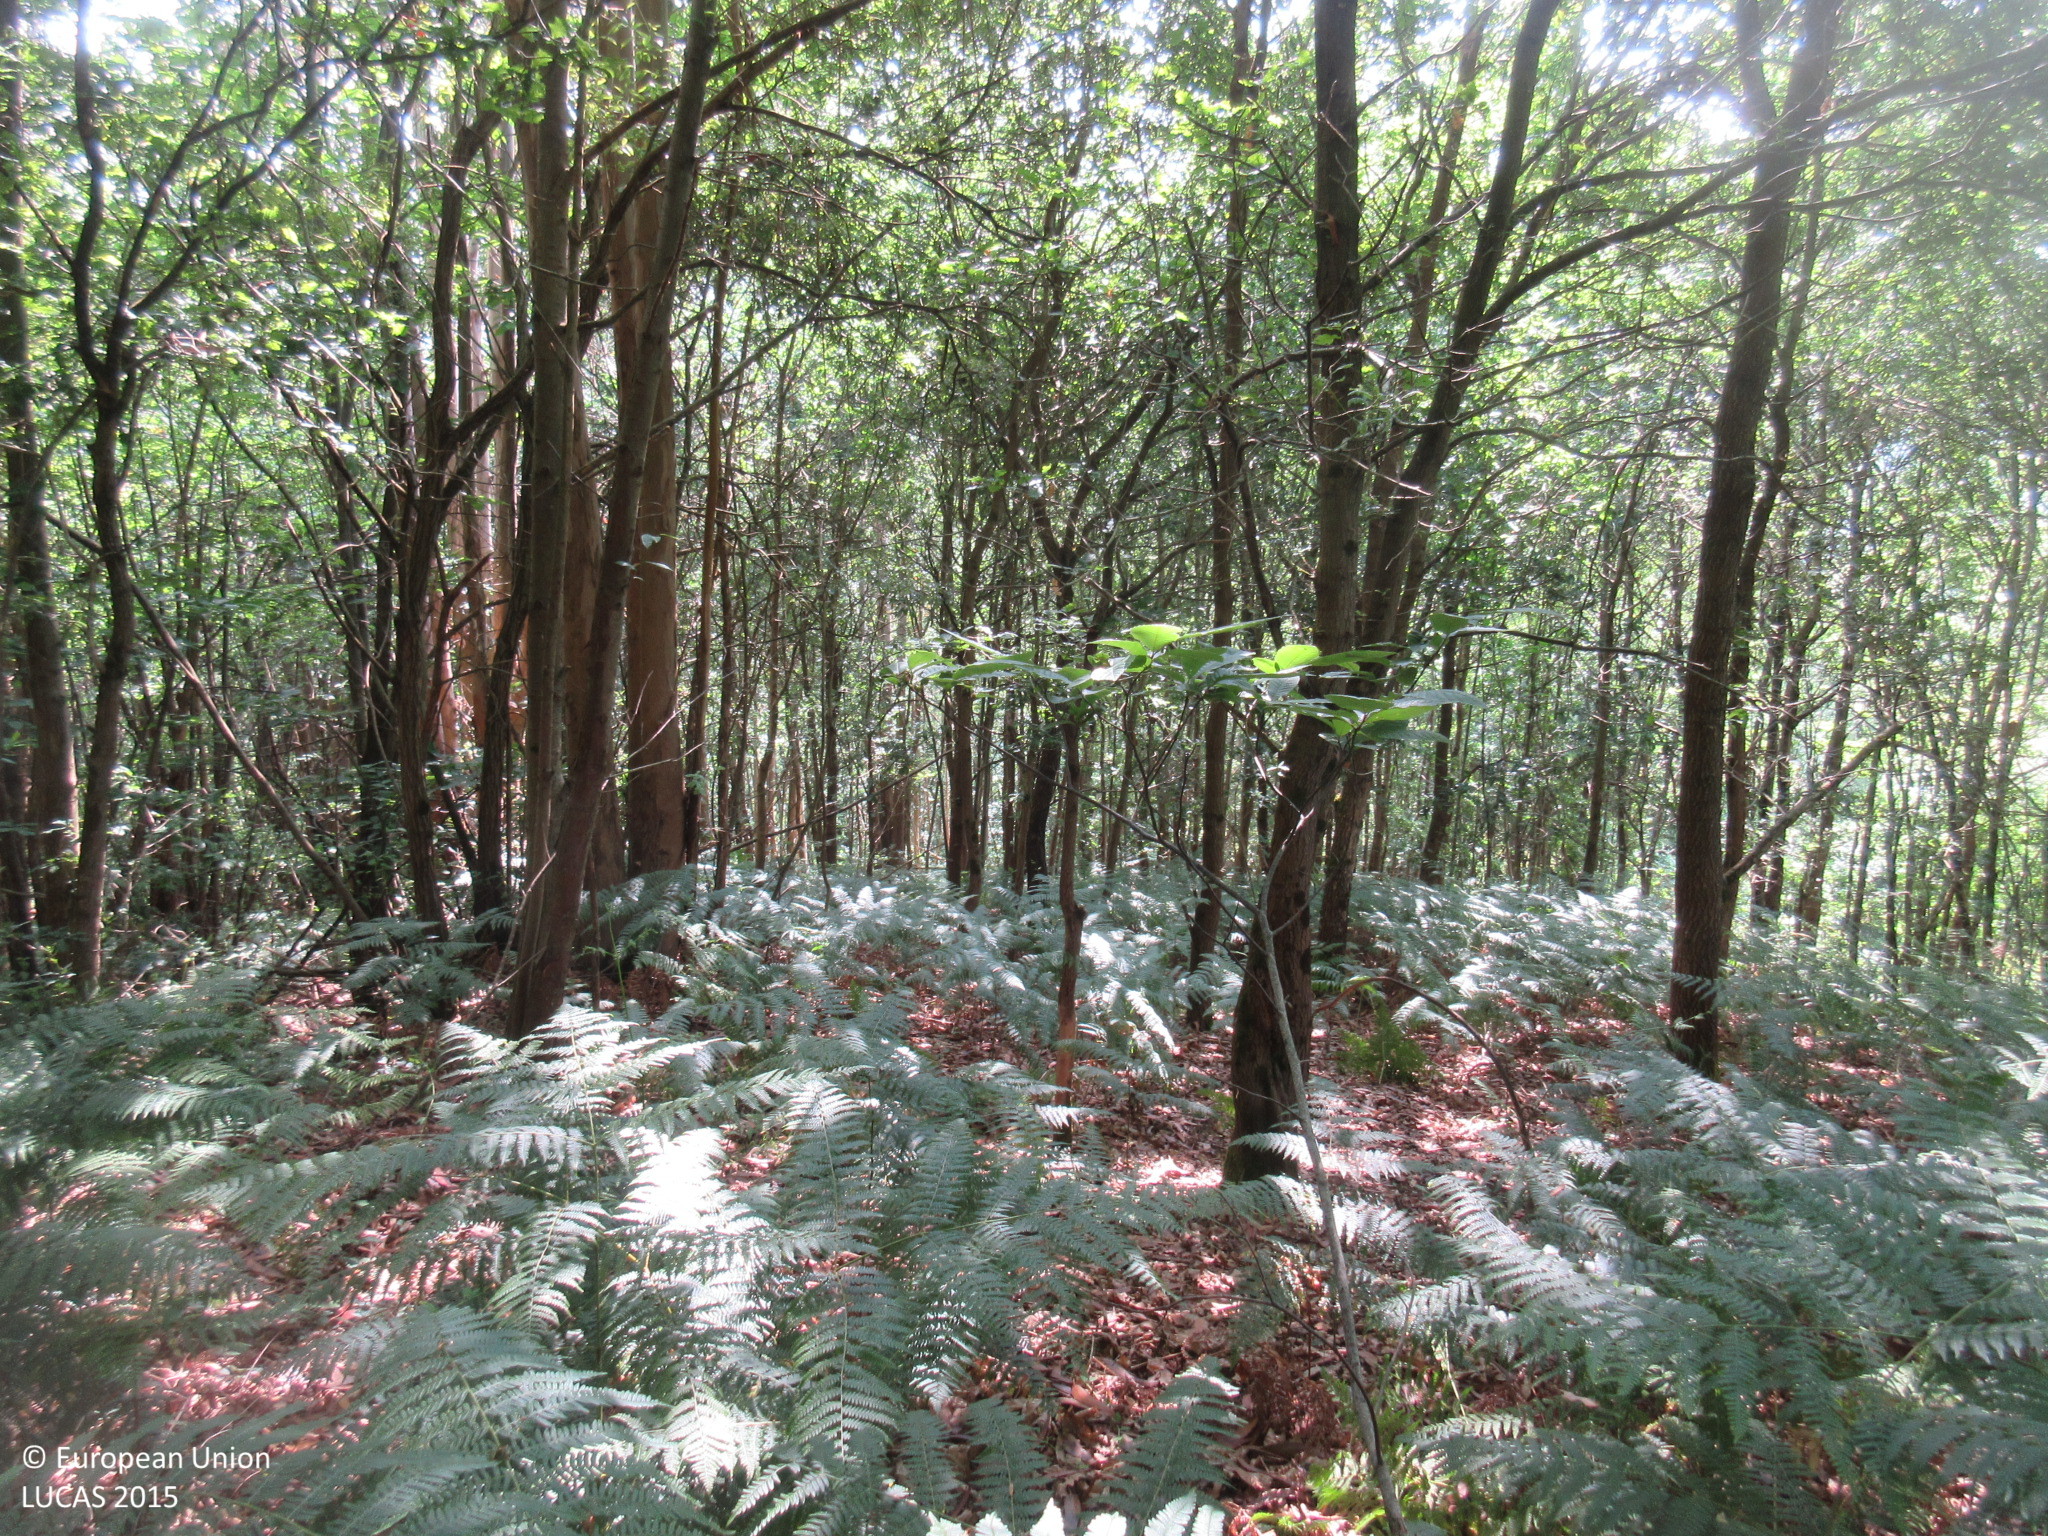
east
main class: Woodland
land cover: Broadleaved woodland
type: thermophilous deciduous forest
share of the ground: > 75 %
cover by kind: broadleaved forest trees 95 %, shrubs 5 %
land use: Forestry
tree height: > 5 m
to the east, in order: Broadleaved woodland; Grassland without tree/shrub cover
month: June
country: ES
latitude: 43.4175
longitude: -5.9615
